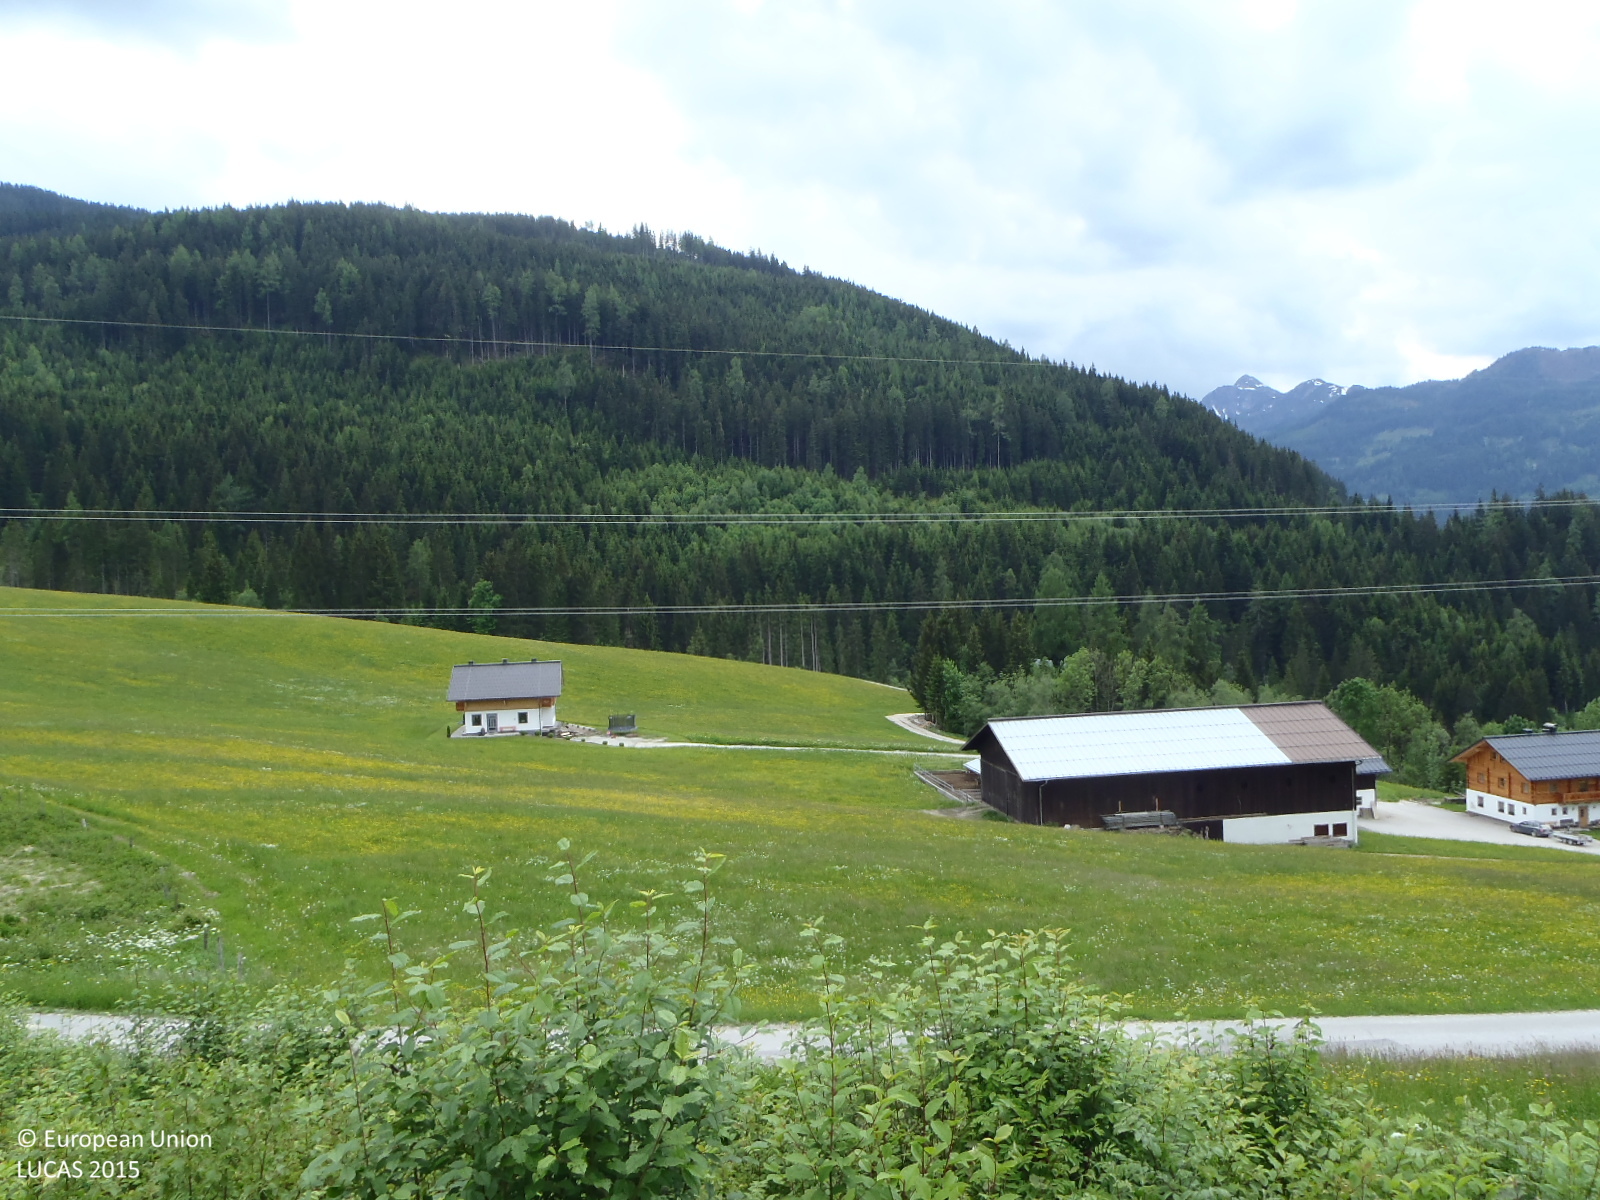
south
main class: Shrubland
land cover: Shrubland with sparse tree cover
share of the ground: > 75 %
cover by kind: shrubs 90 %, broadleaved forest trees 5 %, herbaceous plants 5 %
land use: Forestry
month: June
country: AT
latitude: 47.3751
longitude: 13.5079
